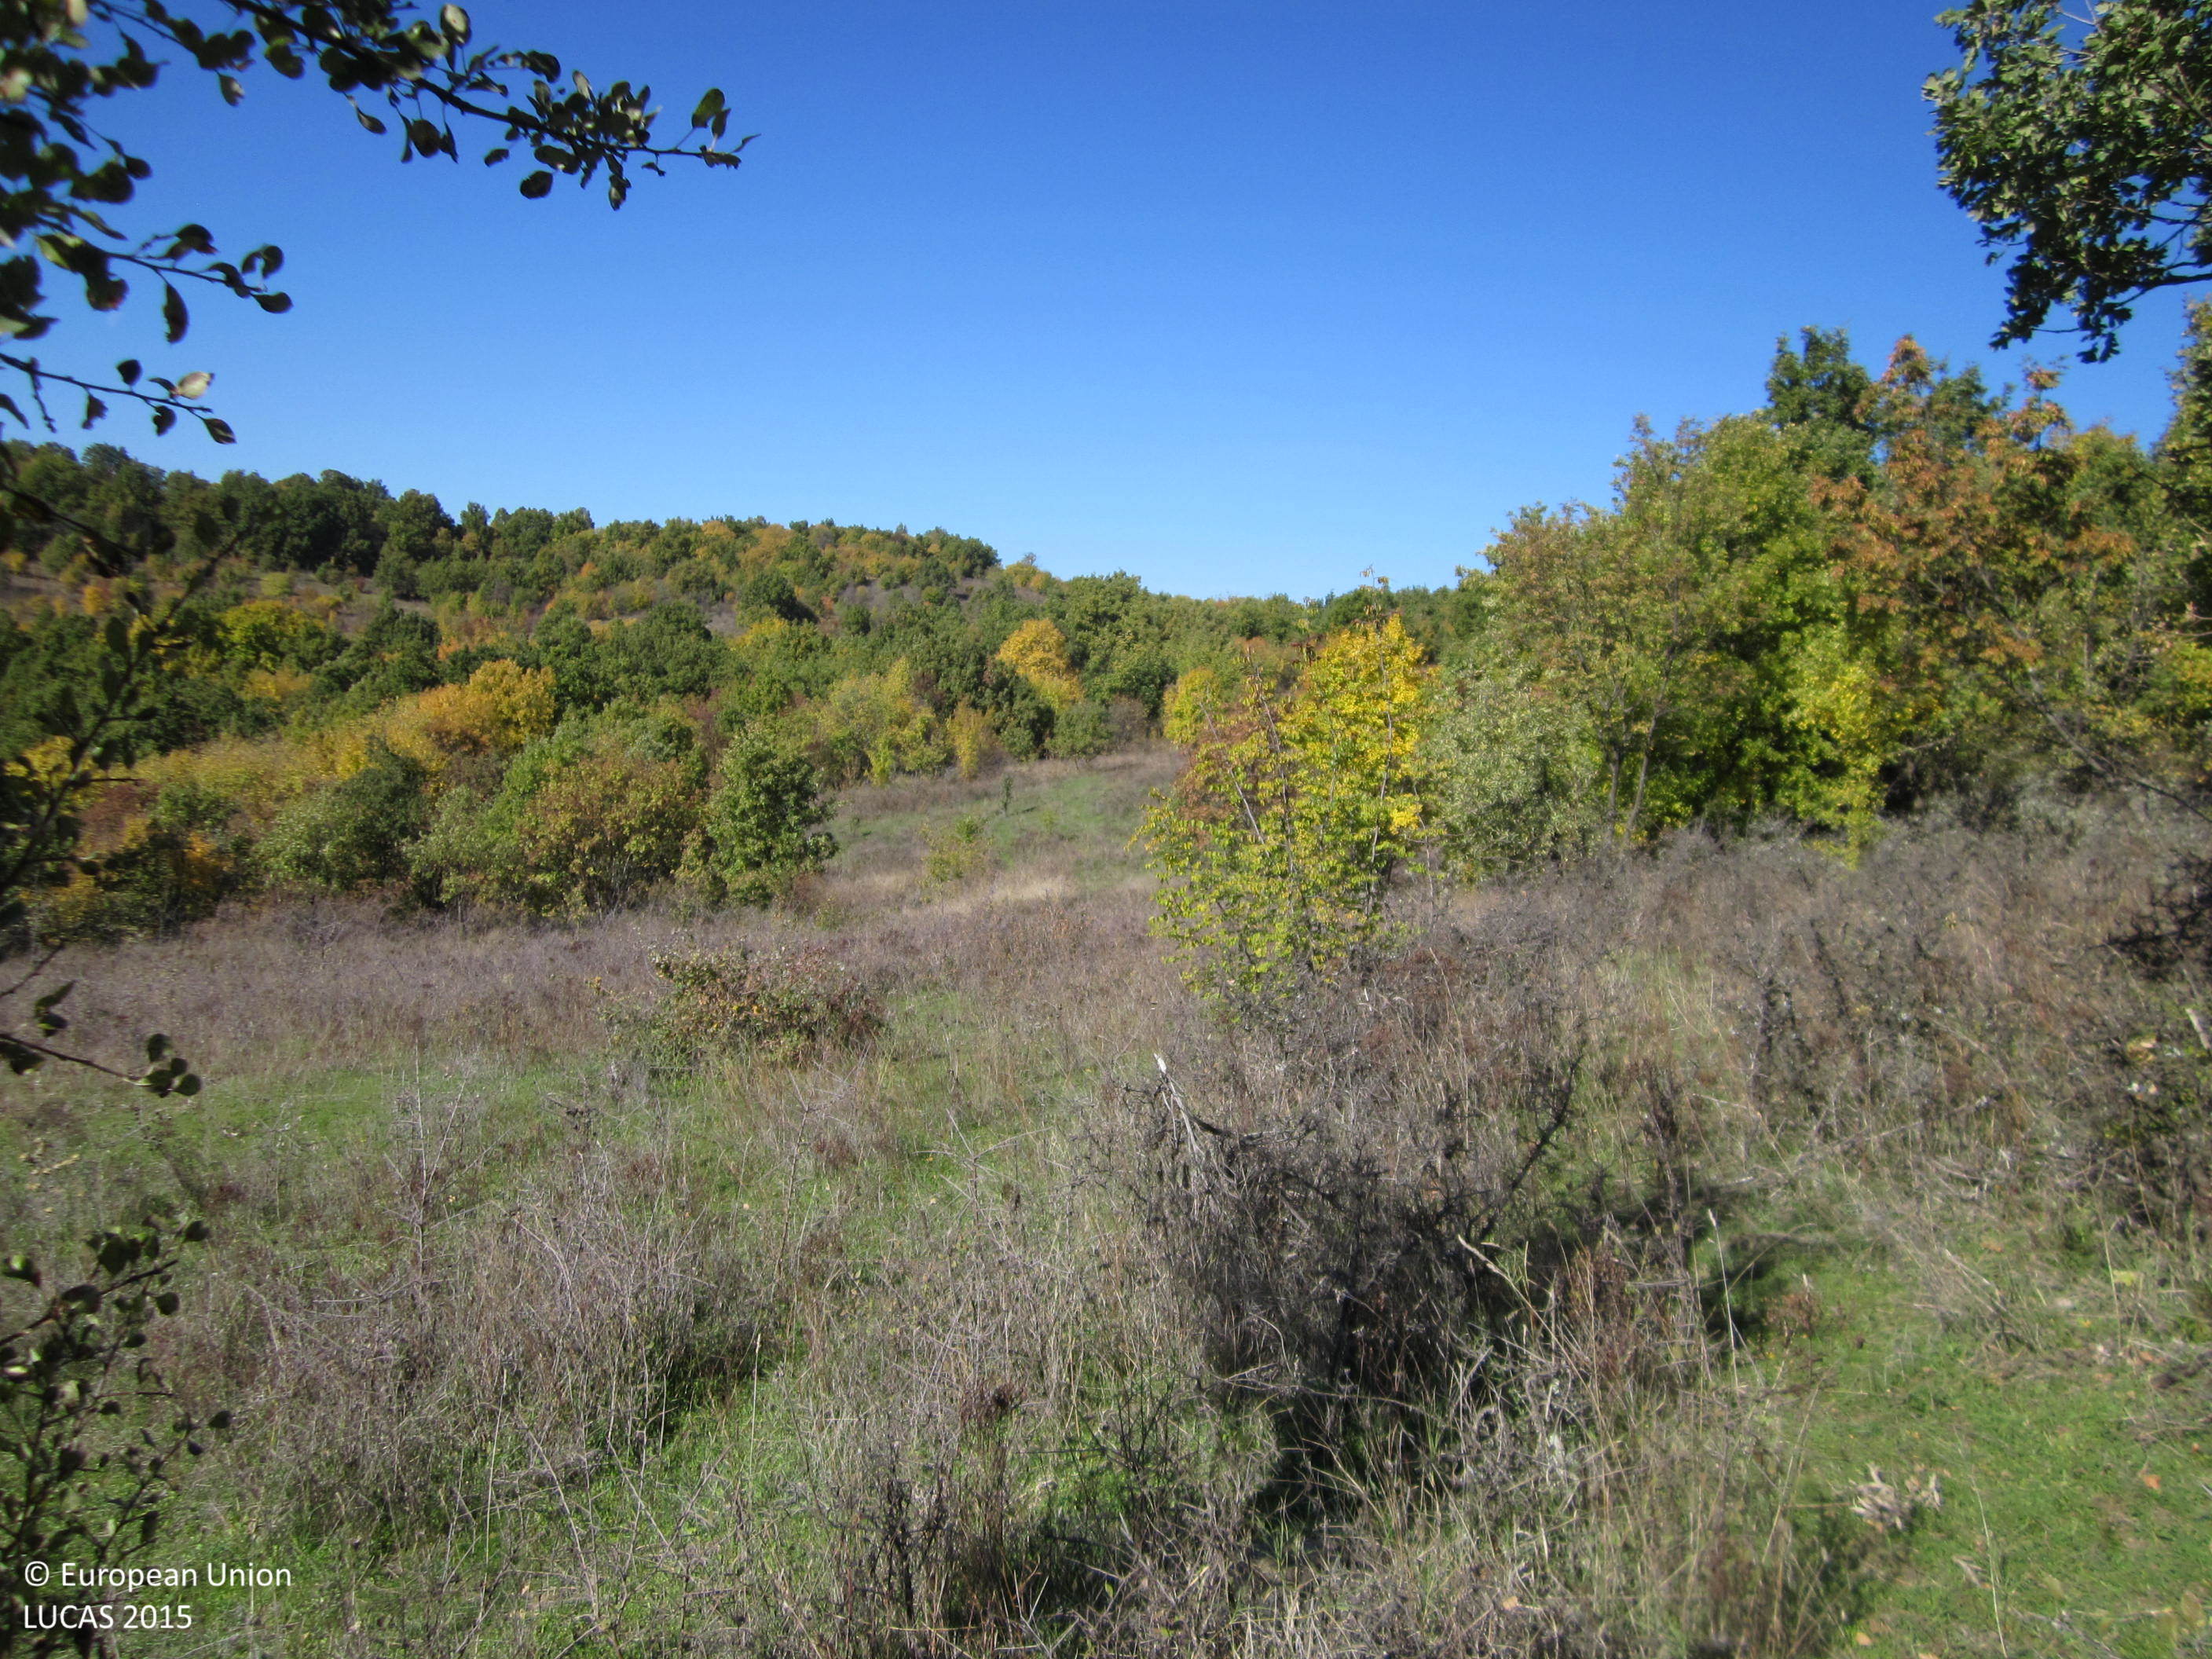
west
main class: Woodland
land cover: Broadleaved woodland
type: hemiboreal forest and nemoral coniferous forest and mixed broadleaved-coniferous forest
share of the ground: > 75 %
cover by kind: broadleaved forest trees 100 %
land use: Forestry
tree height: > 5 m
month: November
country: BG
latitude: 41.4337
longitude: 25.8485
